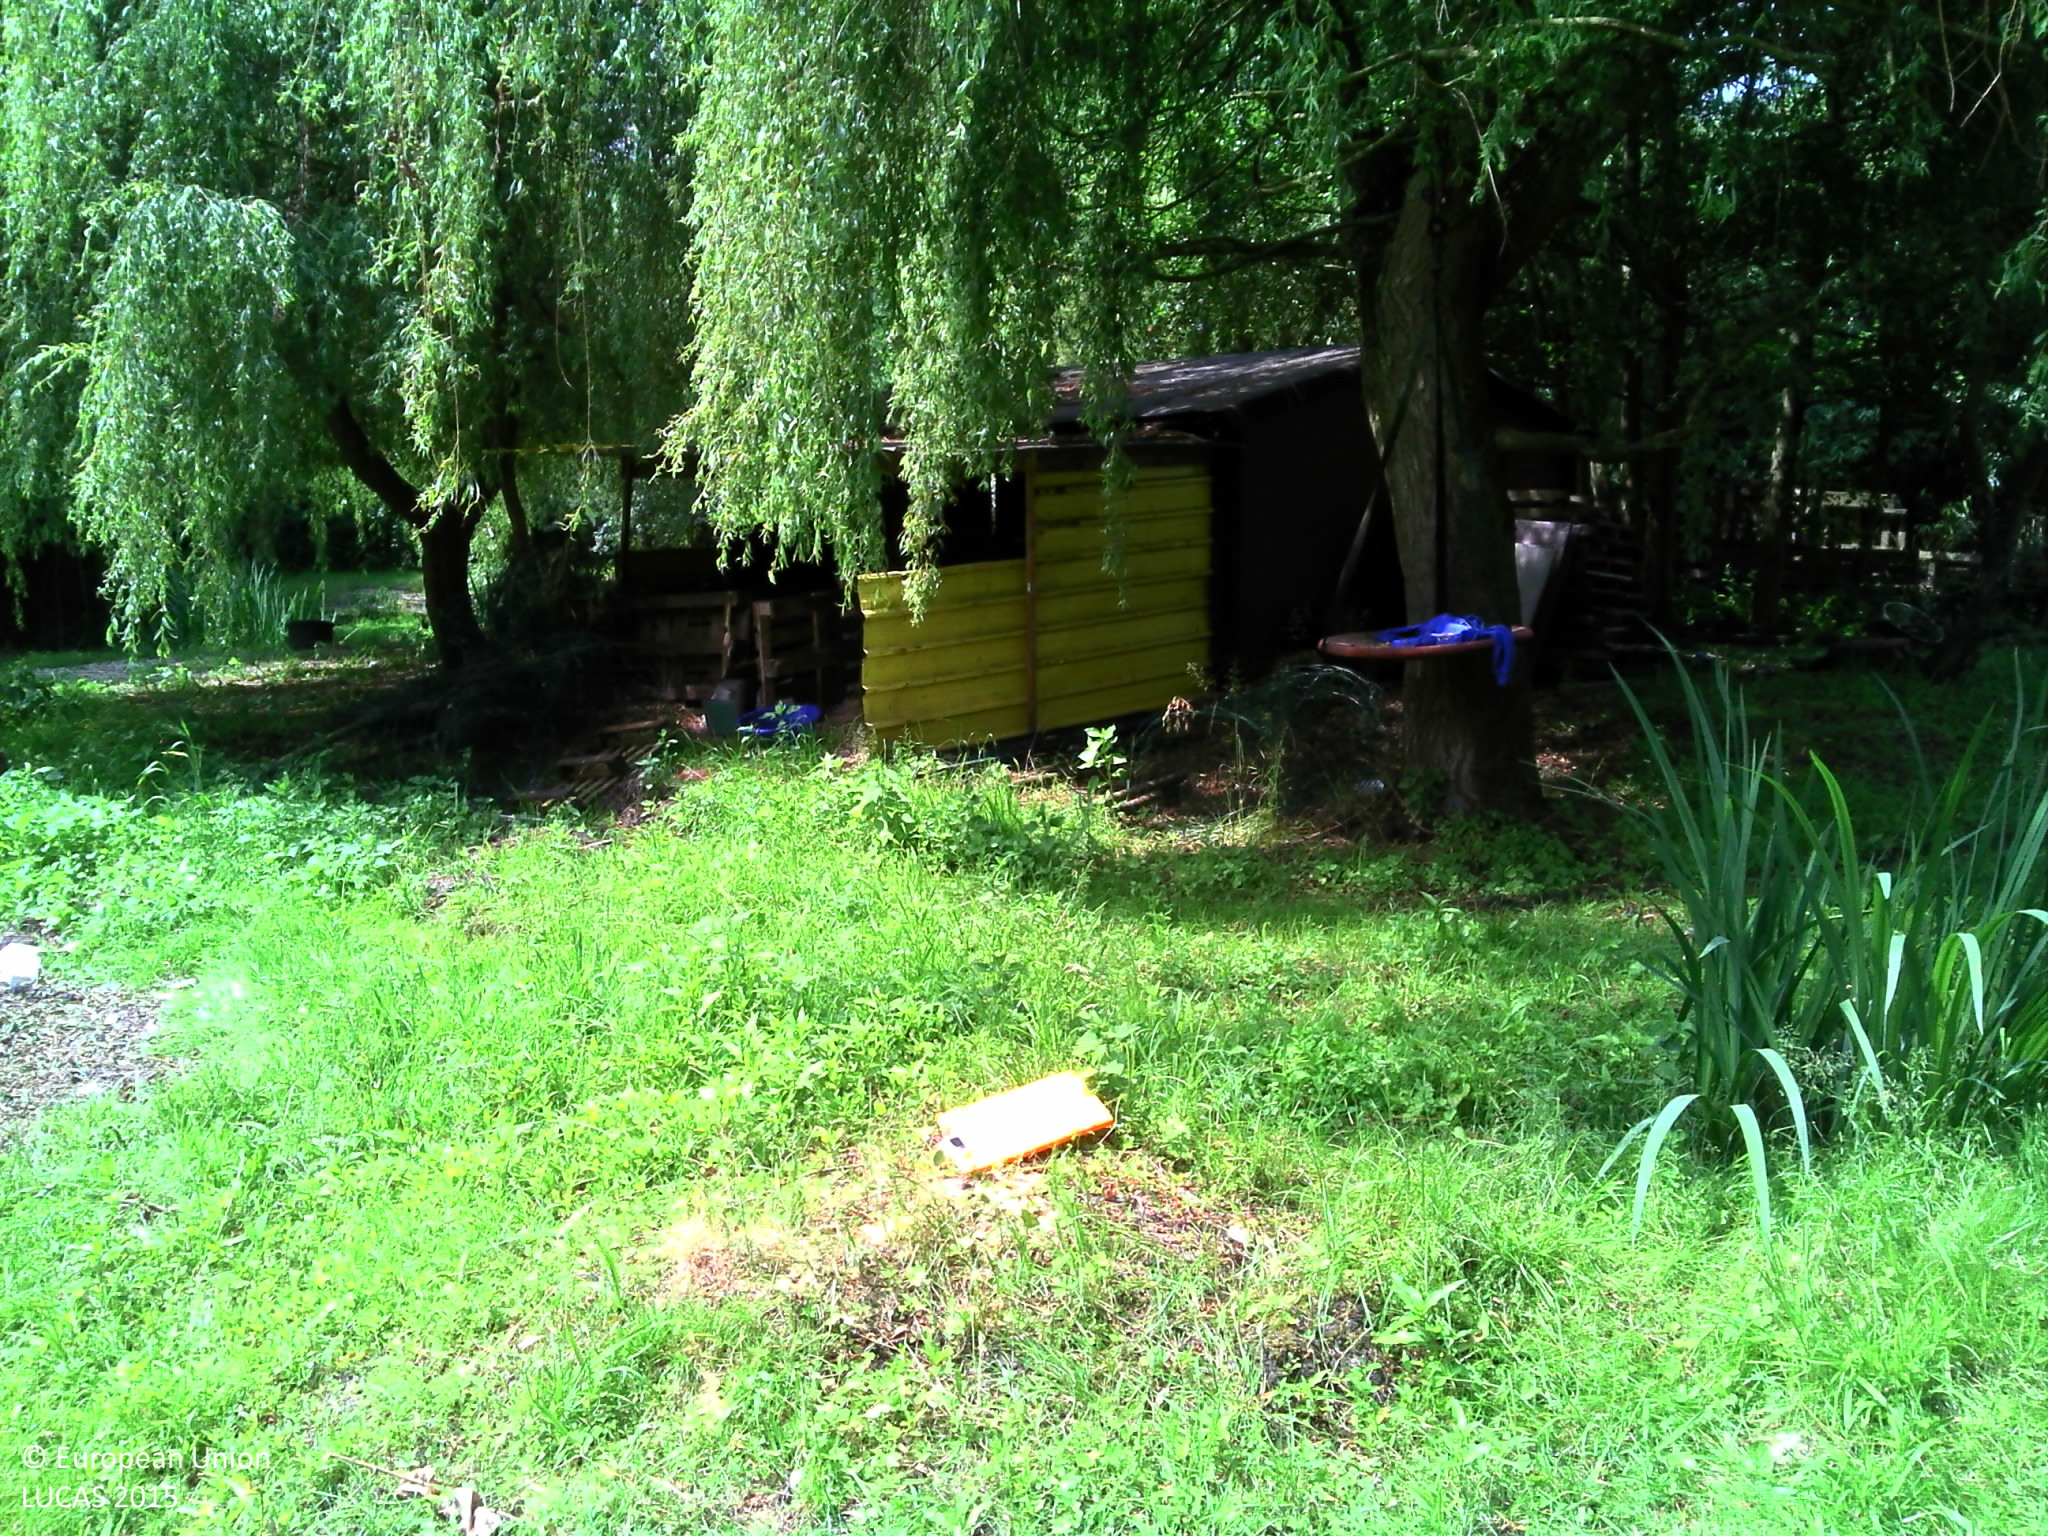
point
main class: Grassland
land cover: Grassland with sparse tree/shrub cover
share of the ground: > 75 %
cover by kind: herbaceous plants 95 %, broadleaved forest trees 5 %
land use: Residential
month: June
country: BE
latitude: 50.4623
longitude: 3.7245
